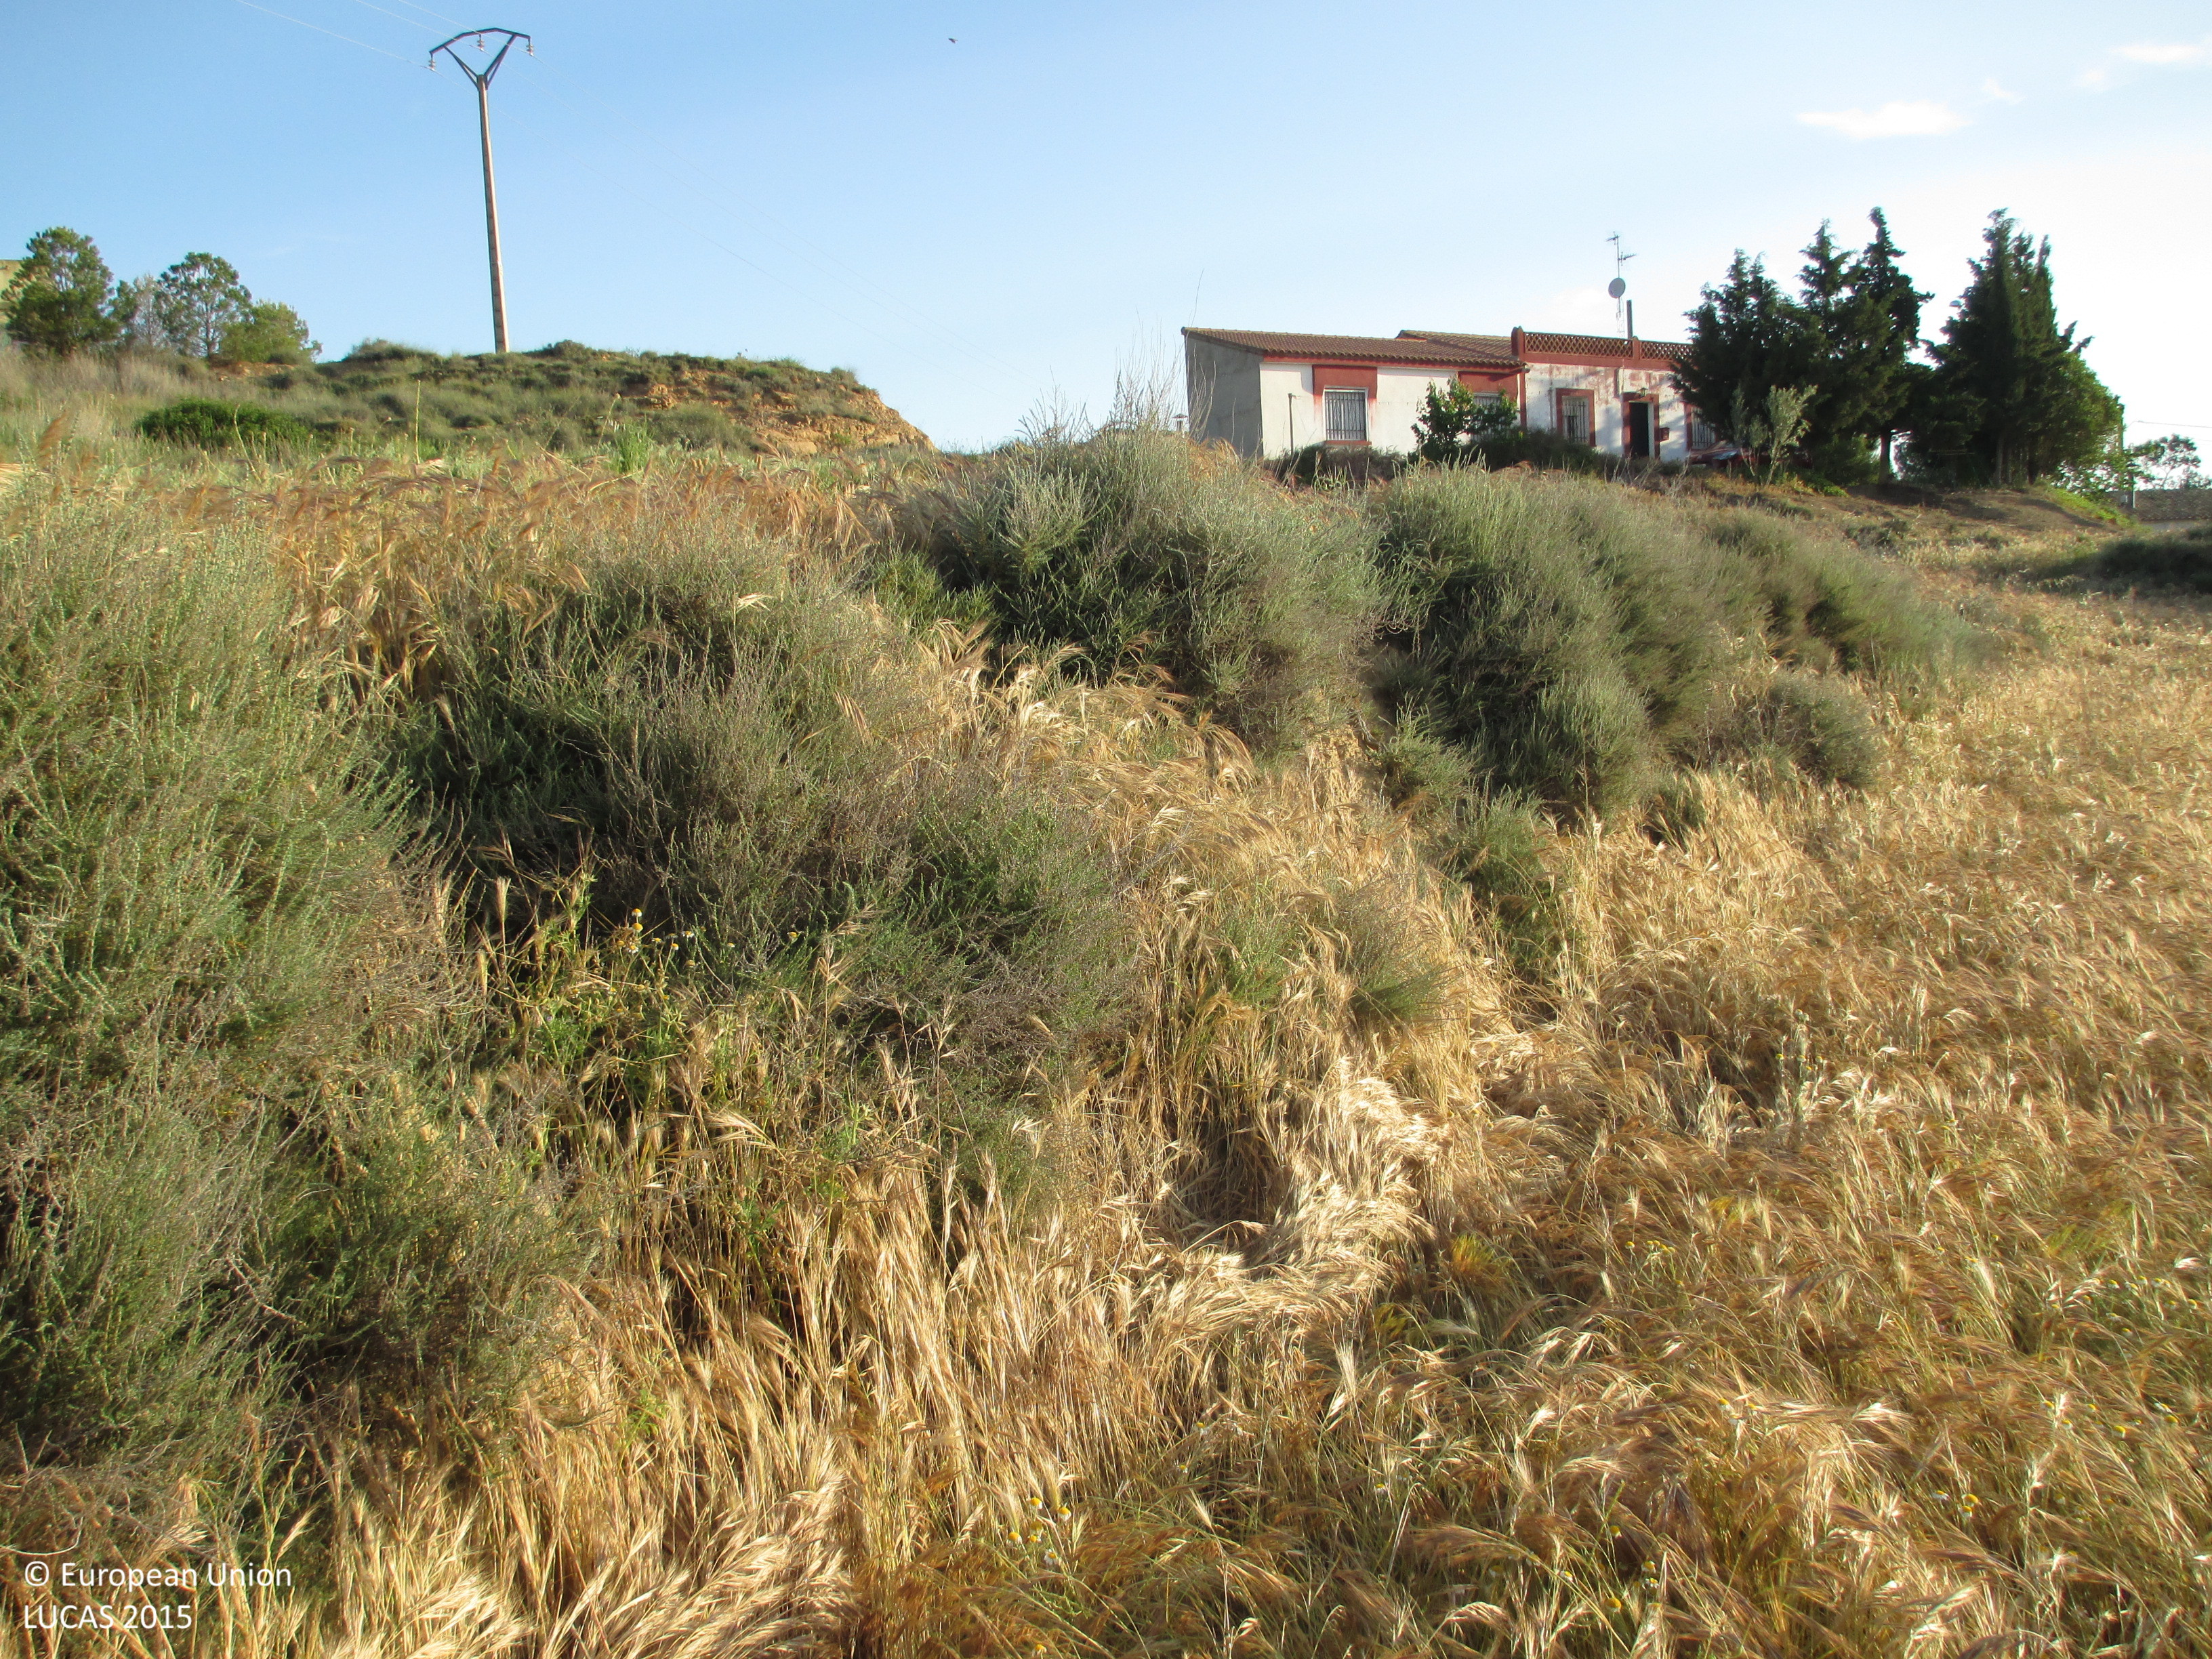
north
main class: Grassland
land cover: Spontaneously vegetated surfaces
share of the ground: > 75 %
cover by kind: herbaceous plants 100 %
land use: Fallow land
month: May
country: ES
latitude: 41.9933
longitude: -0.3664
